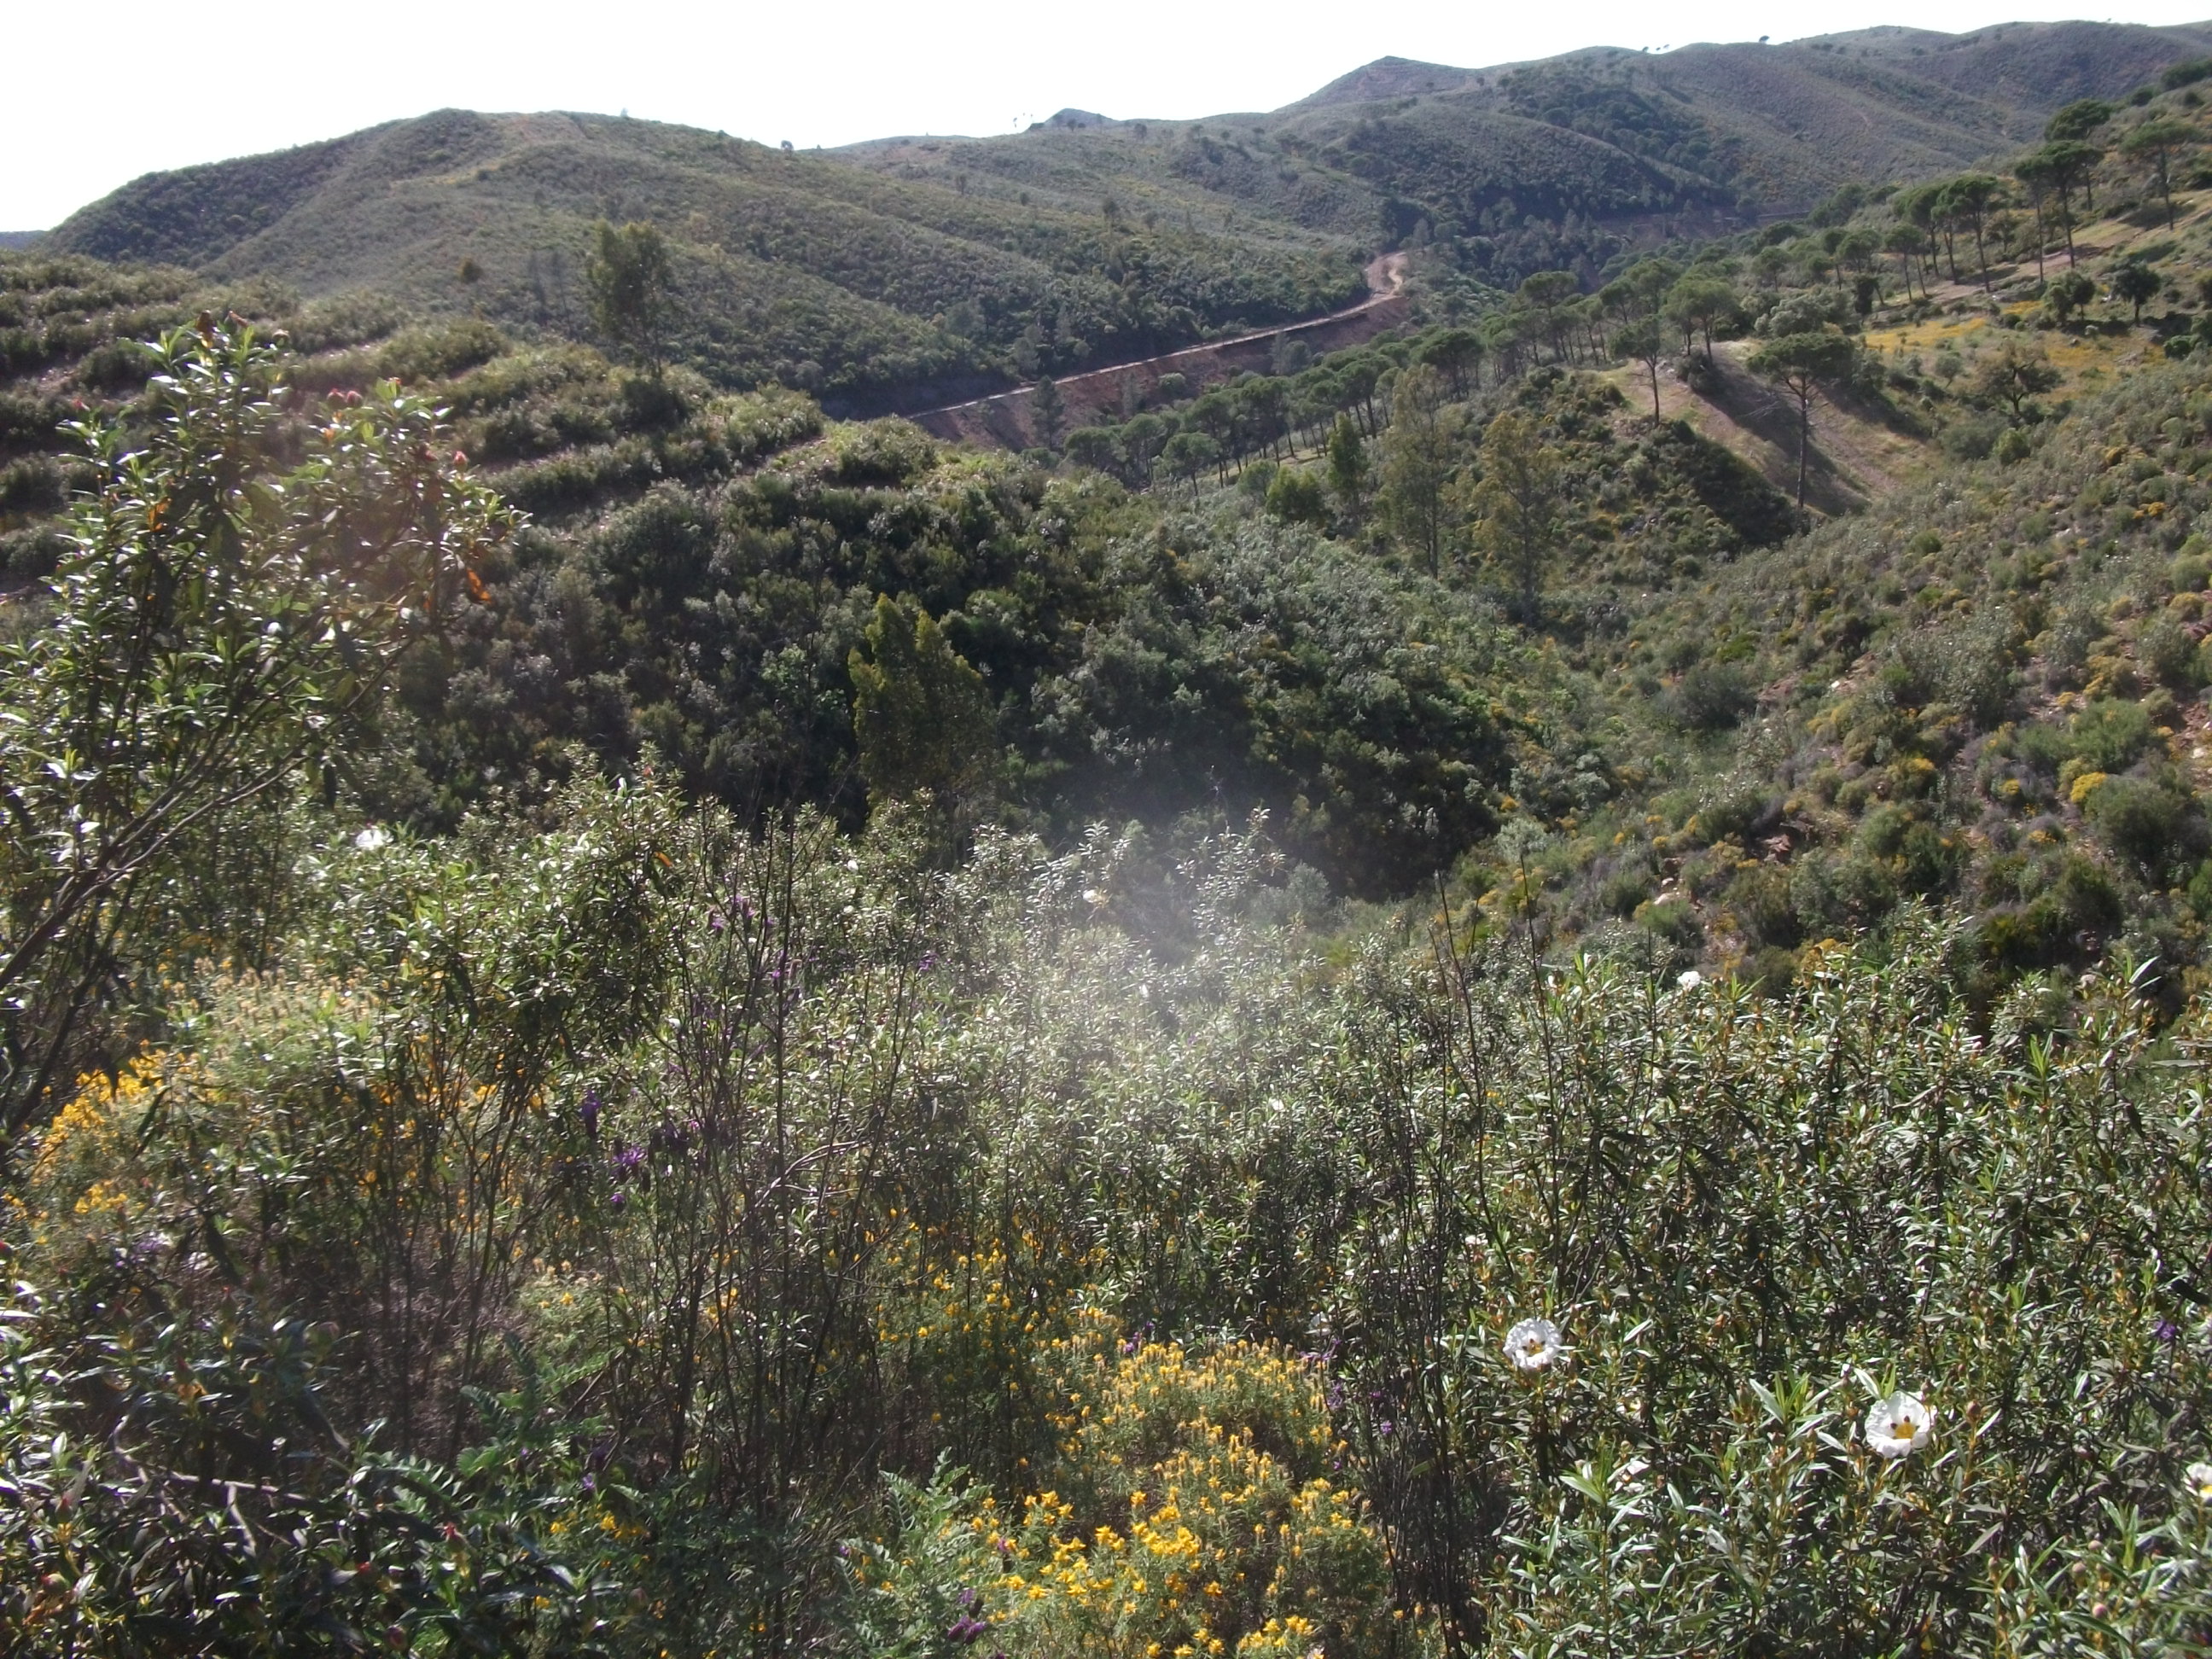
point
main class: Shrubland
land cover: Shrubland without tree cover
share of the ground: > 75 %
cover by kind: shrubs 100 %
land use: Semi-natural and natural areas not in use
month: April
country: ES
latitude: 37.6380
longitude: -6.5265
